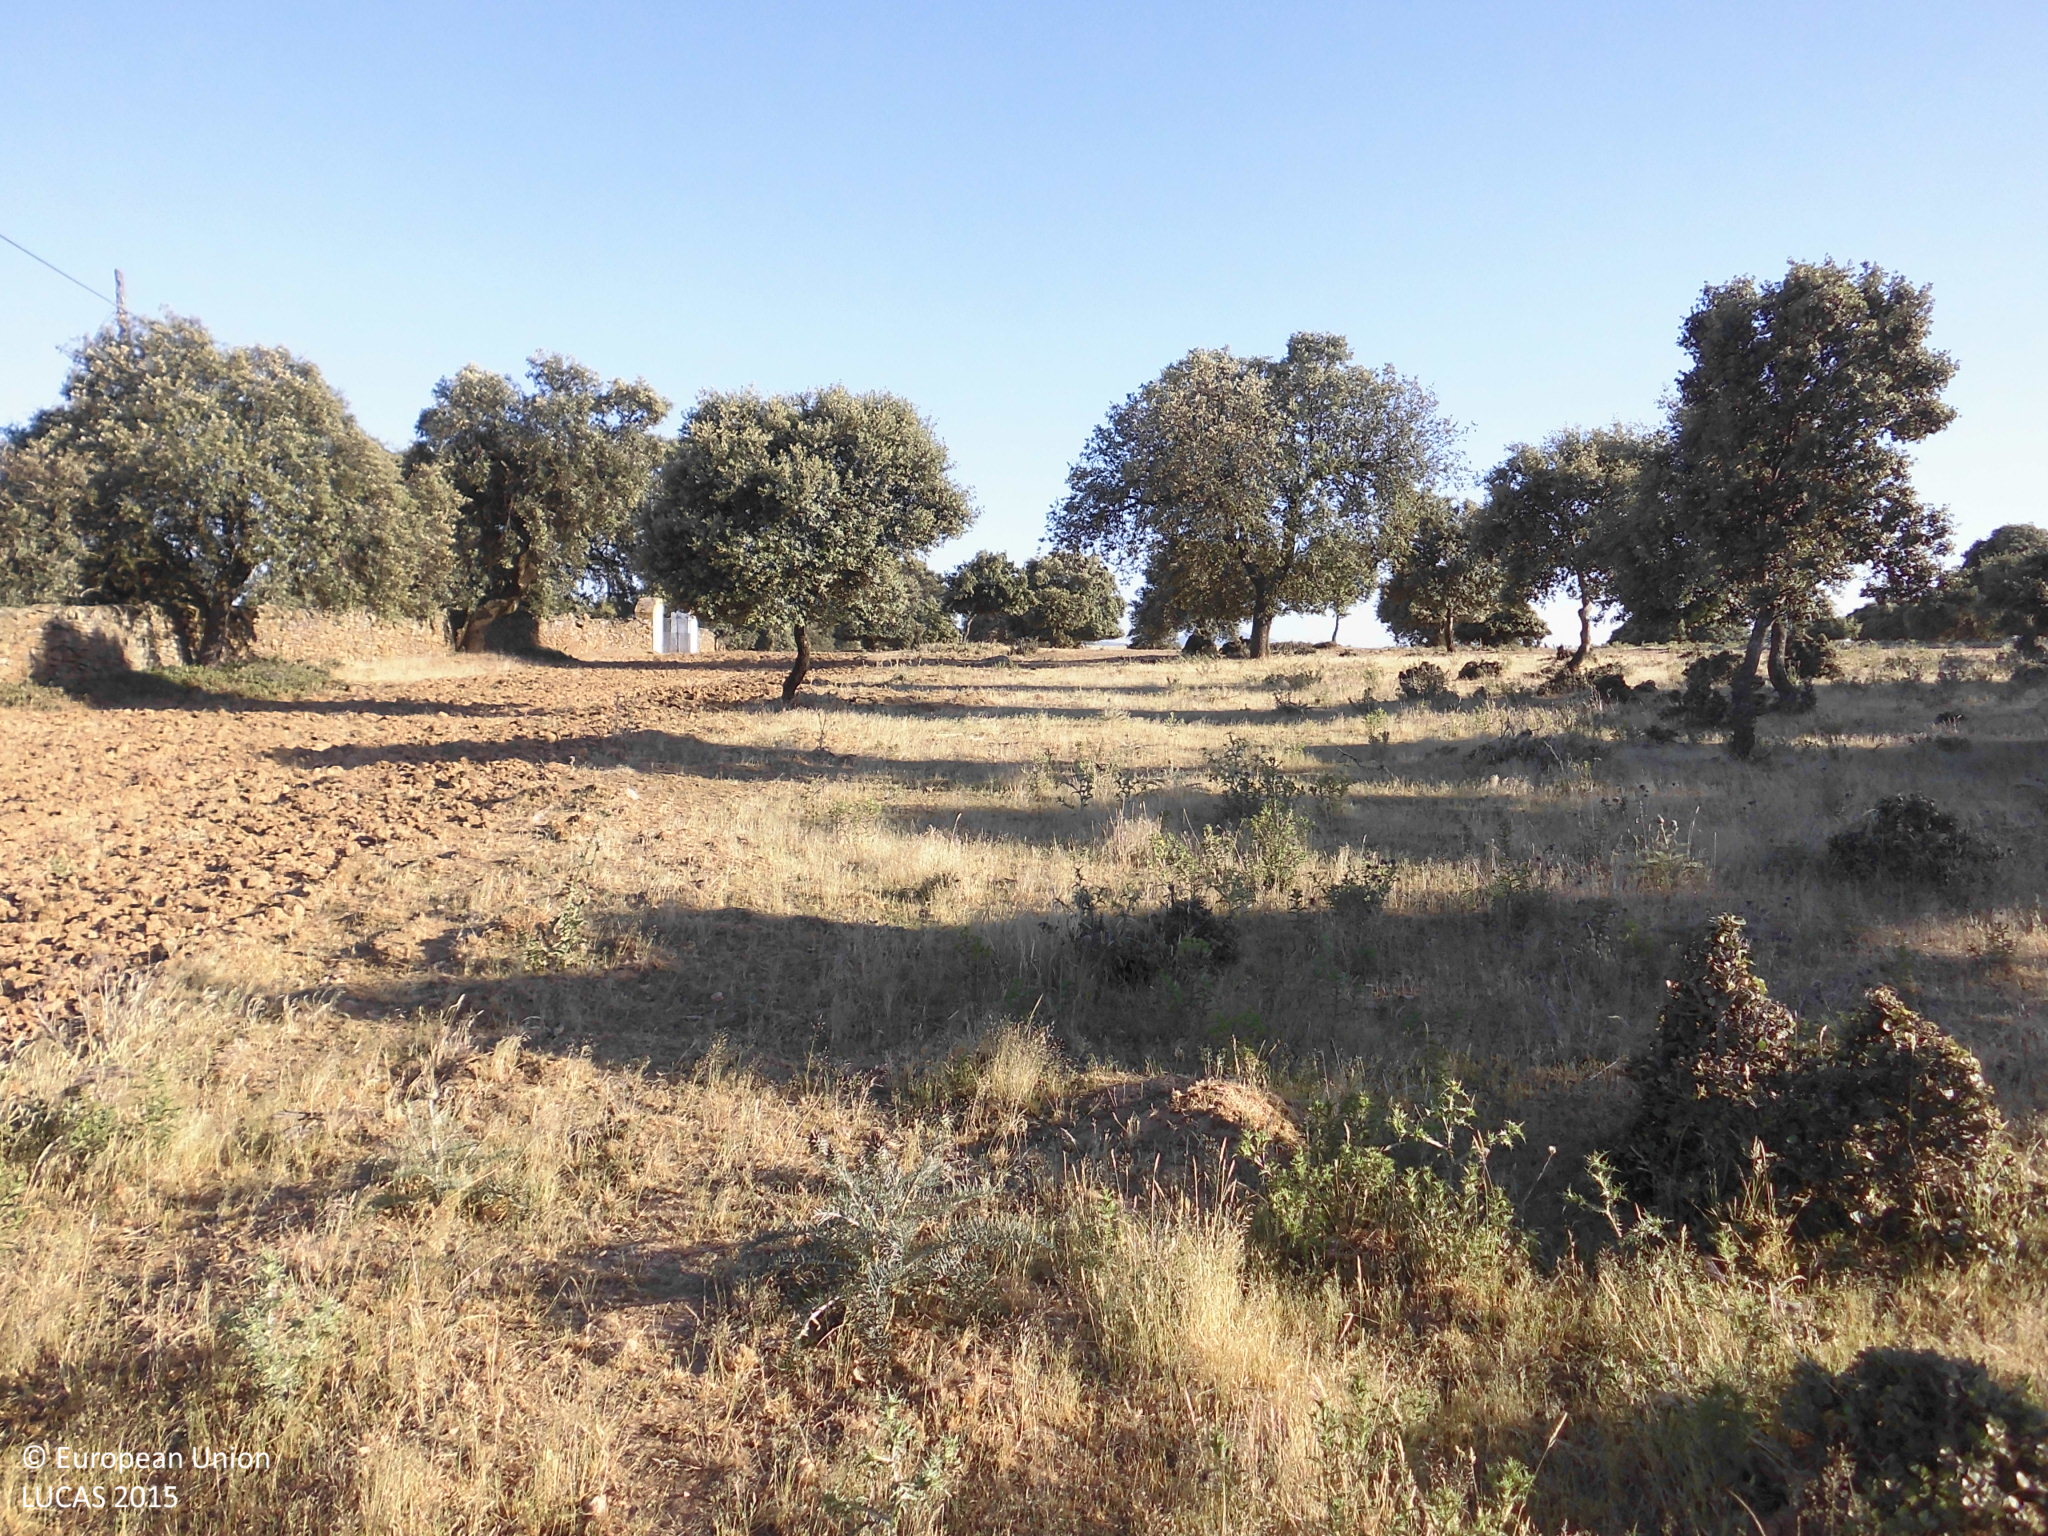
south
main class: Grassland
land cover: Grassland with sparse tree/shrub cover
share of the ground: > 75 %
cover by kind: herbaceous plants 85 %, broadleaved forest trees 5 %, shrubs 5 %, unconsolidated bare surface 5 %
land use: Agriculture (excluding fallow land and kitchen gardens)
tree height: < 5 m
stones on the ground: < 10 %
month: May
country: ES
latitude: 39.4255
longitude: -5.9859
